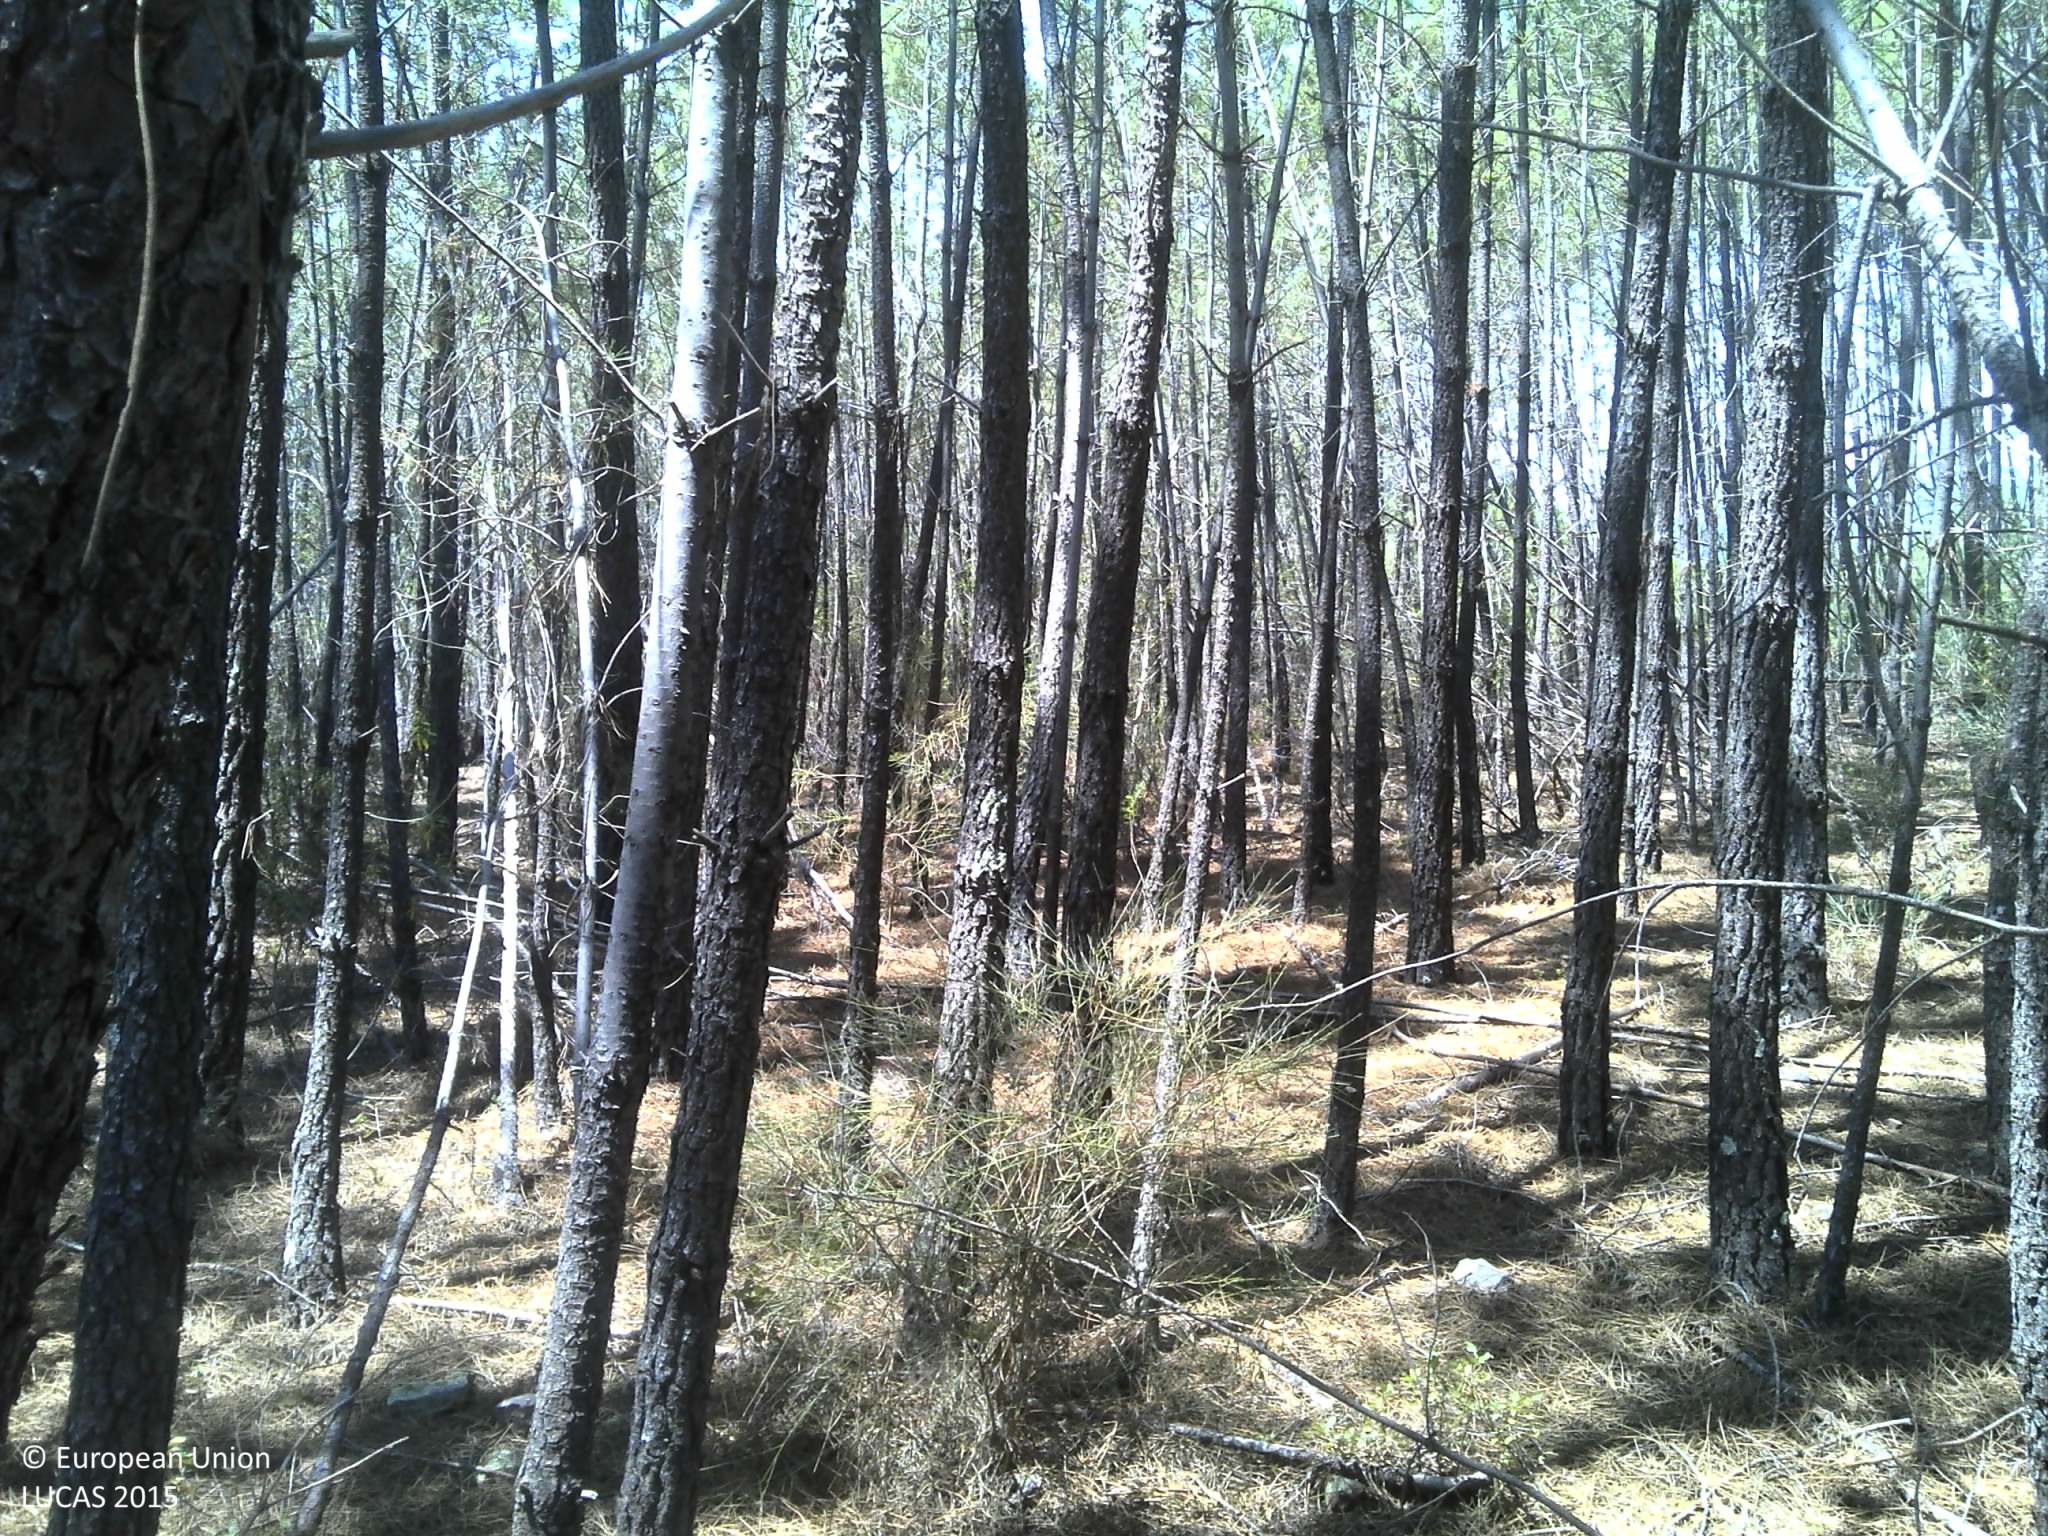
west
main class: Woodland
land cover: Pine dominated coniferous woodland
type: coniferous forest of the mediterranean region
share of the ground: > 75 %
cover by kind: coniferous forest trees 80 %, shrubs 5 %, herbaceous plants 5 %, unconsolidated bare surface 5 %
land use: Forestry
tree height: > 5 m
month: June
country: PT
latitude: 40.0525
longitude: -7.0547
